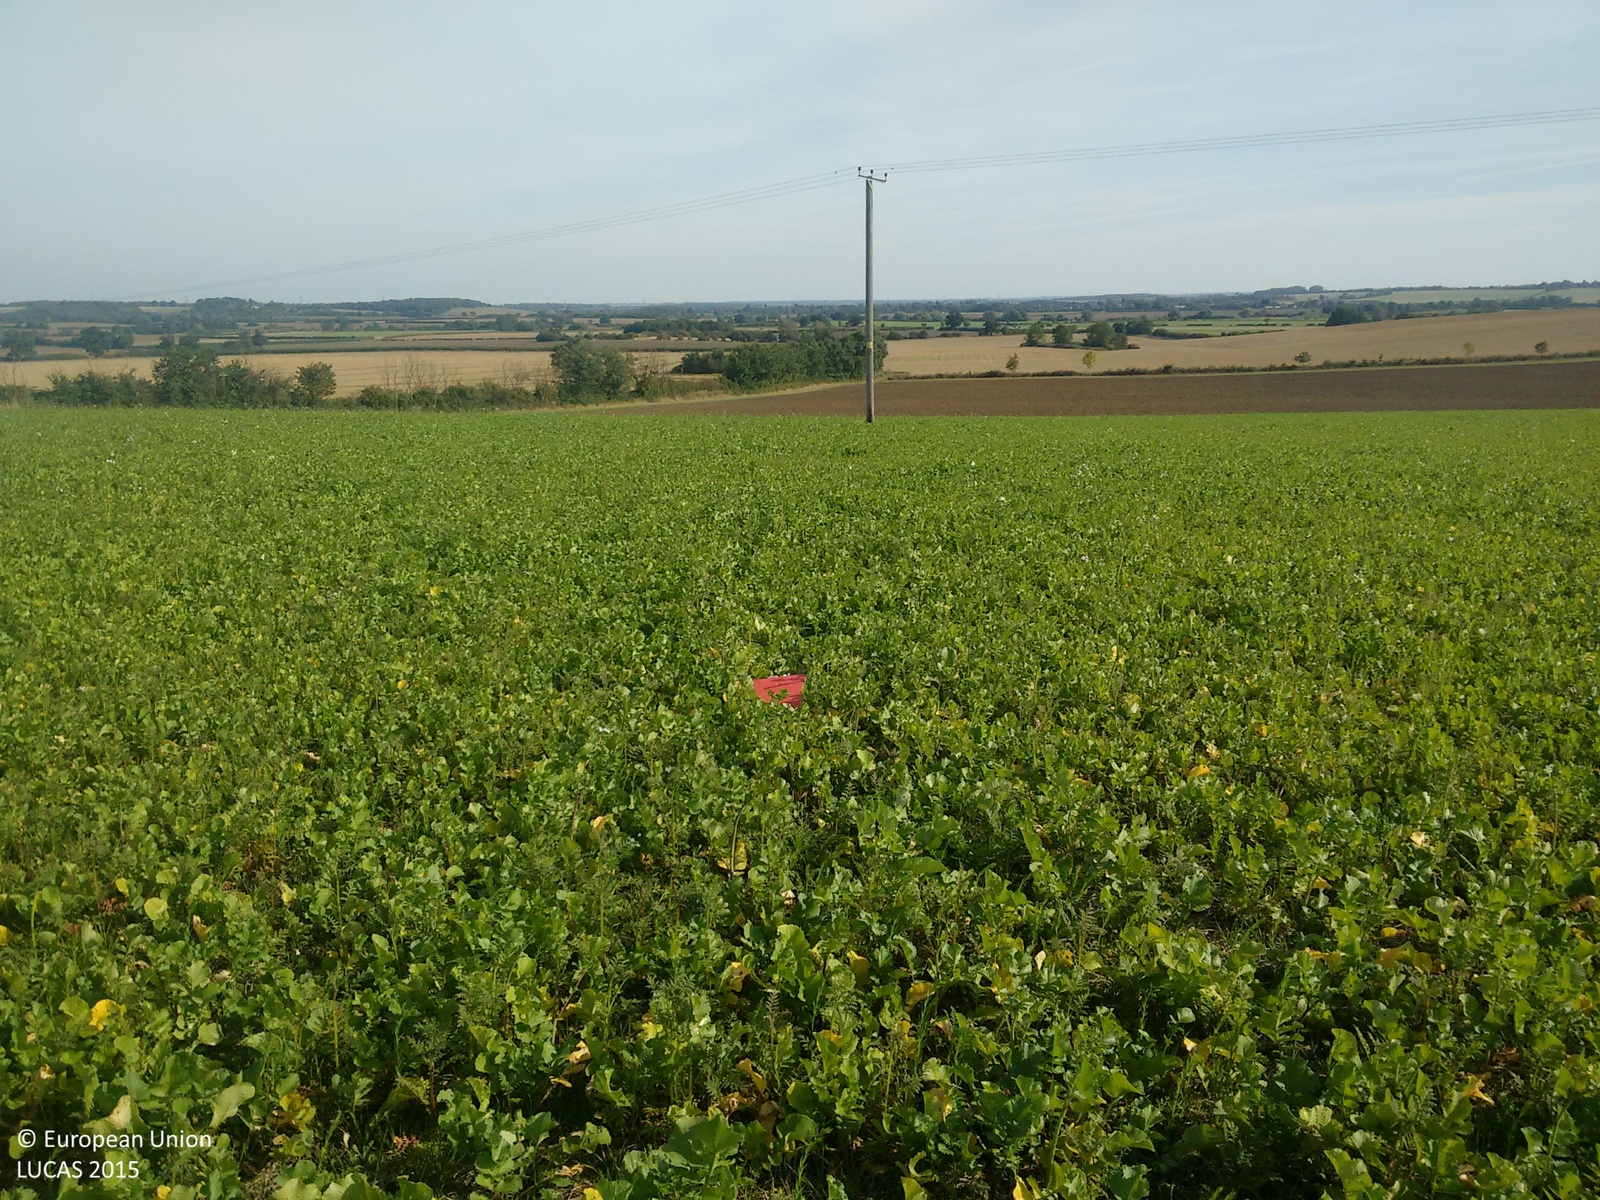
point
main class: Grassland
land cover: Spontaneously vegetated surfaces
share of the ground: > 75 %
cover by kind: herbaceous plants 100 %
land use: Fallow land
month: September
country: GB
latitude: 52.2820
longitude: -0.4004
